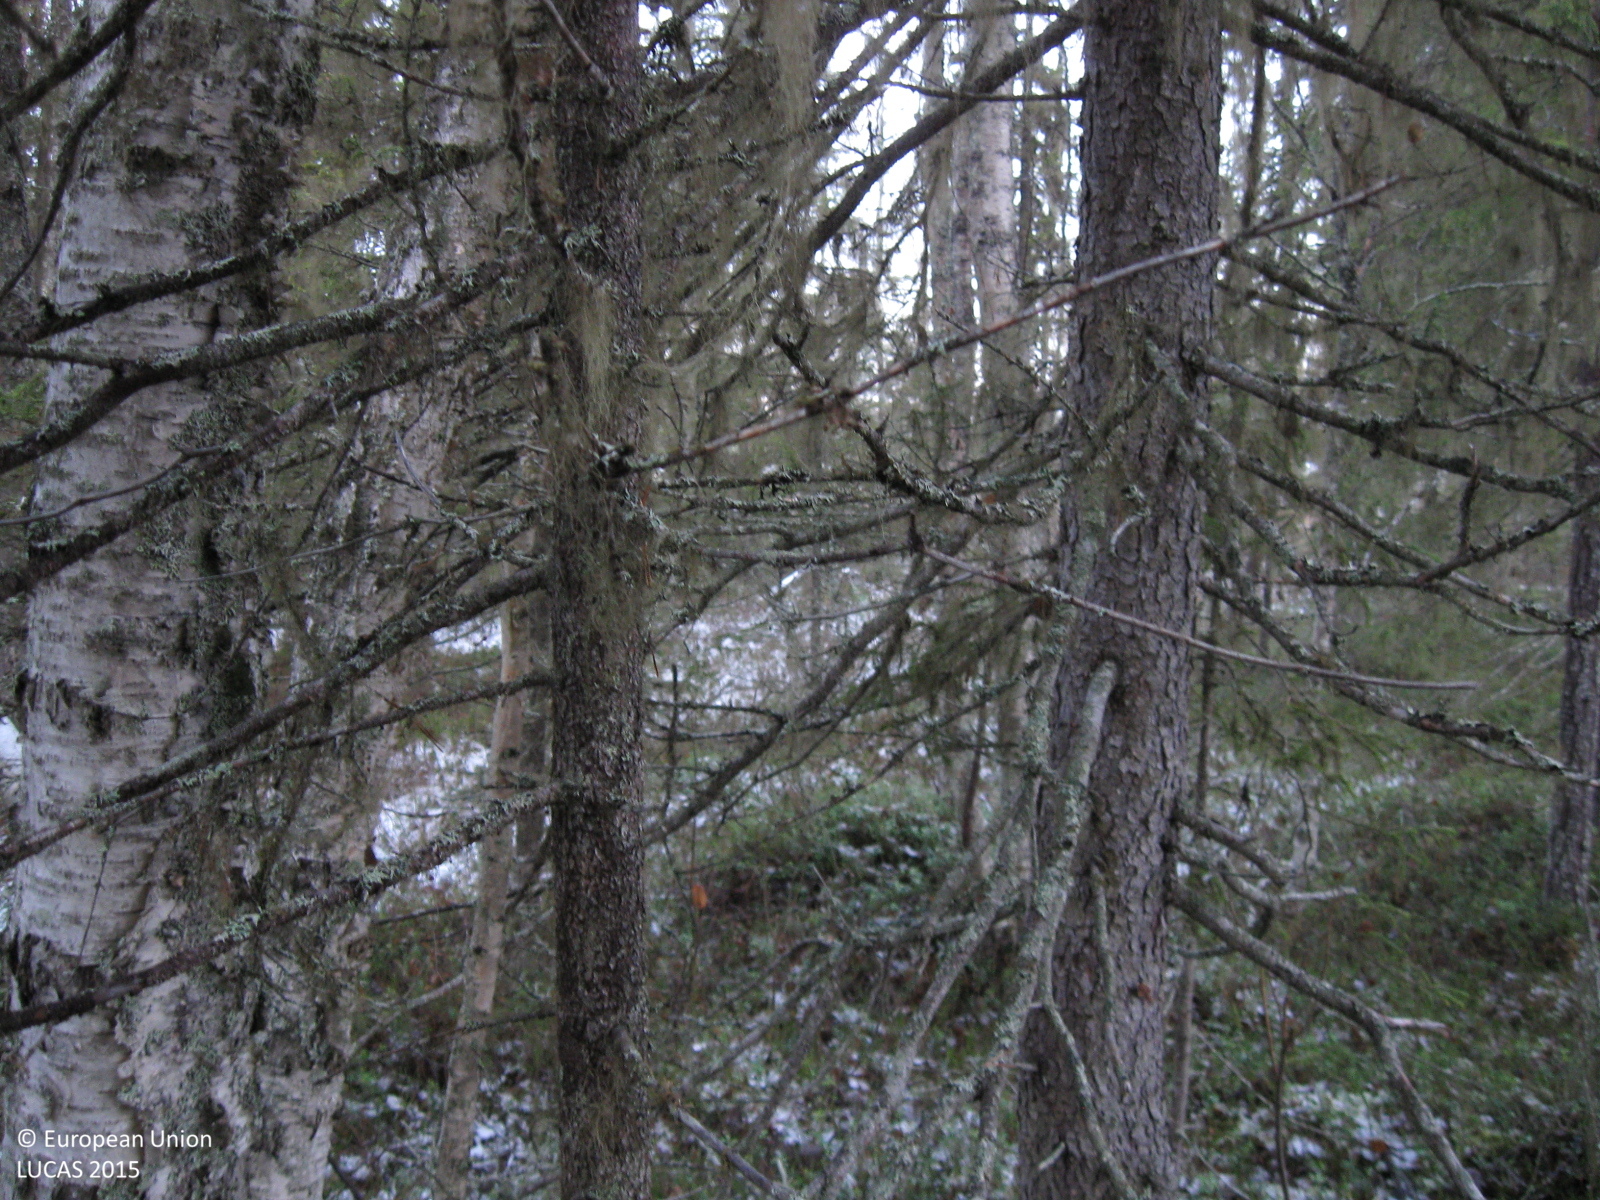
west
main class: Woodland
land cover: Spruce dominated mixed woodland
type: boreal forest
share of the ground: > 75 %
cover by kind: coniferous forest trees 55 %, broadleaved forest trees 20 %, shrubs 10 %, herbaceous plants 10 %, lichens and mosses 5 %
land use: Forestry
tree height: > 5 m
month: October
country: SE
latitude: 66.3478
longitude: 20.8383
